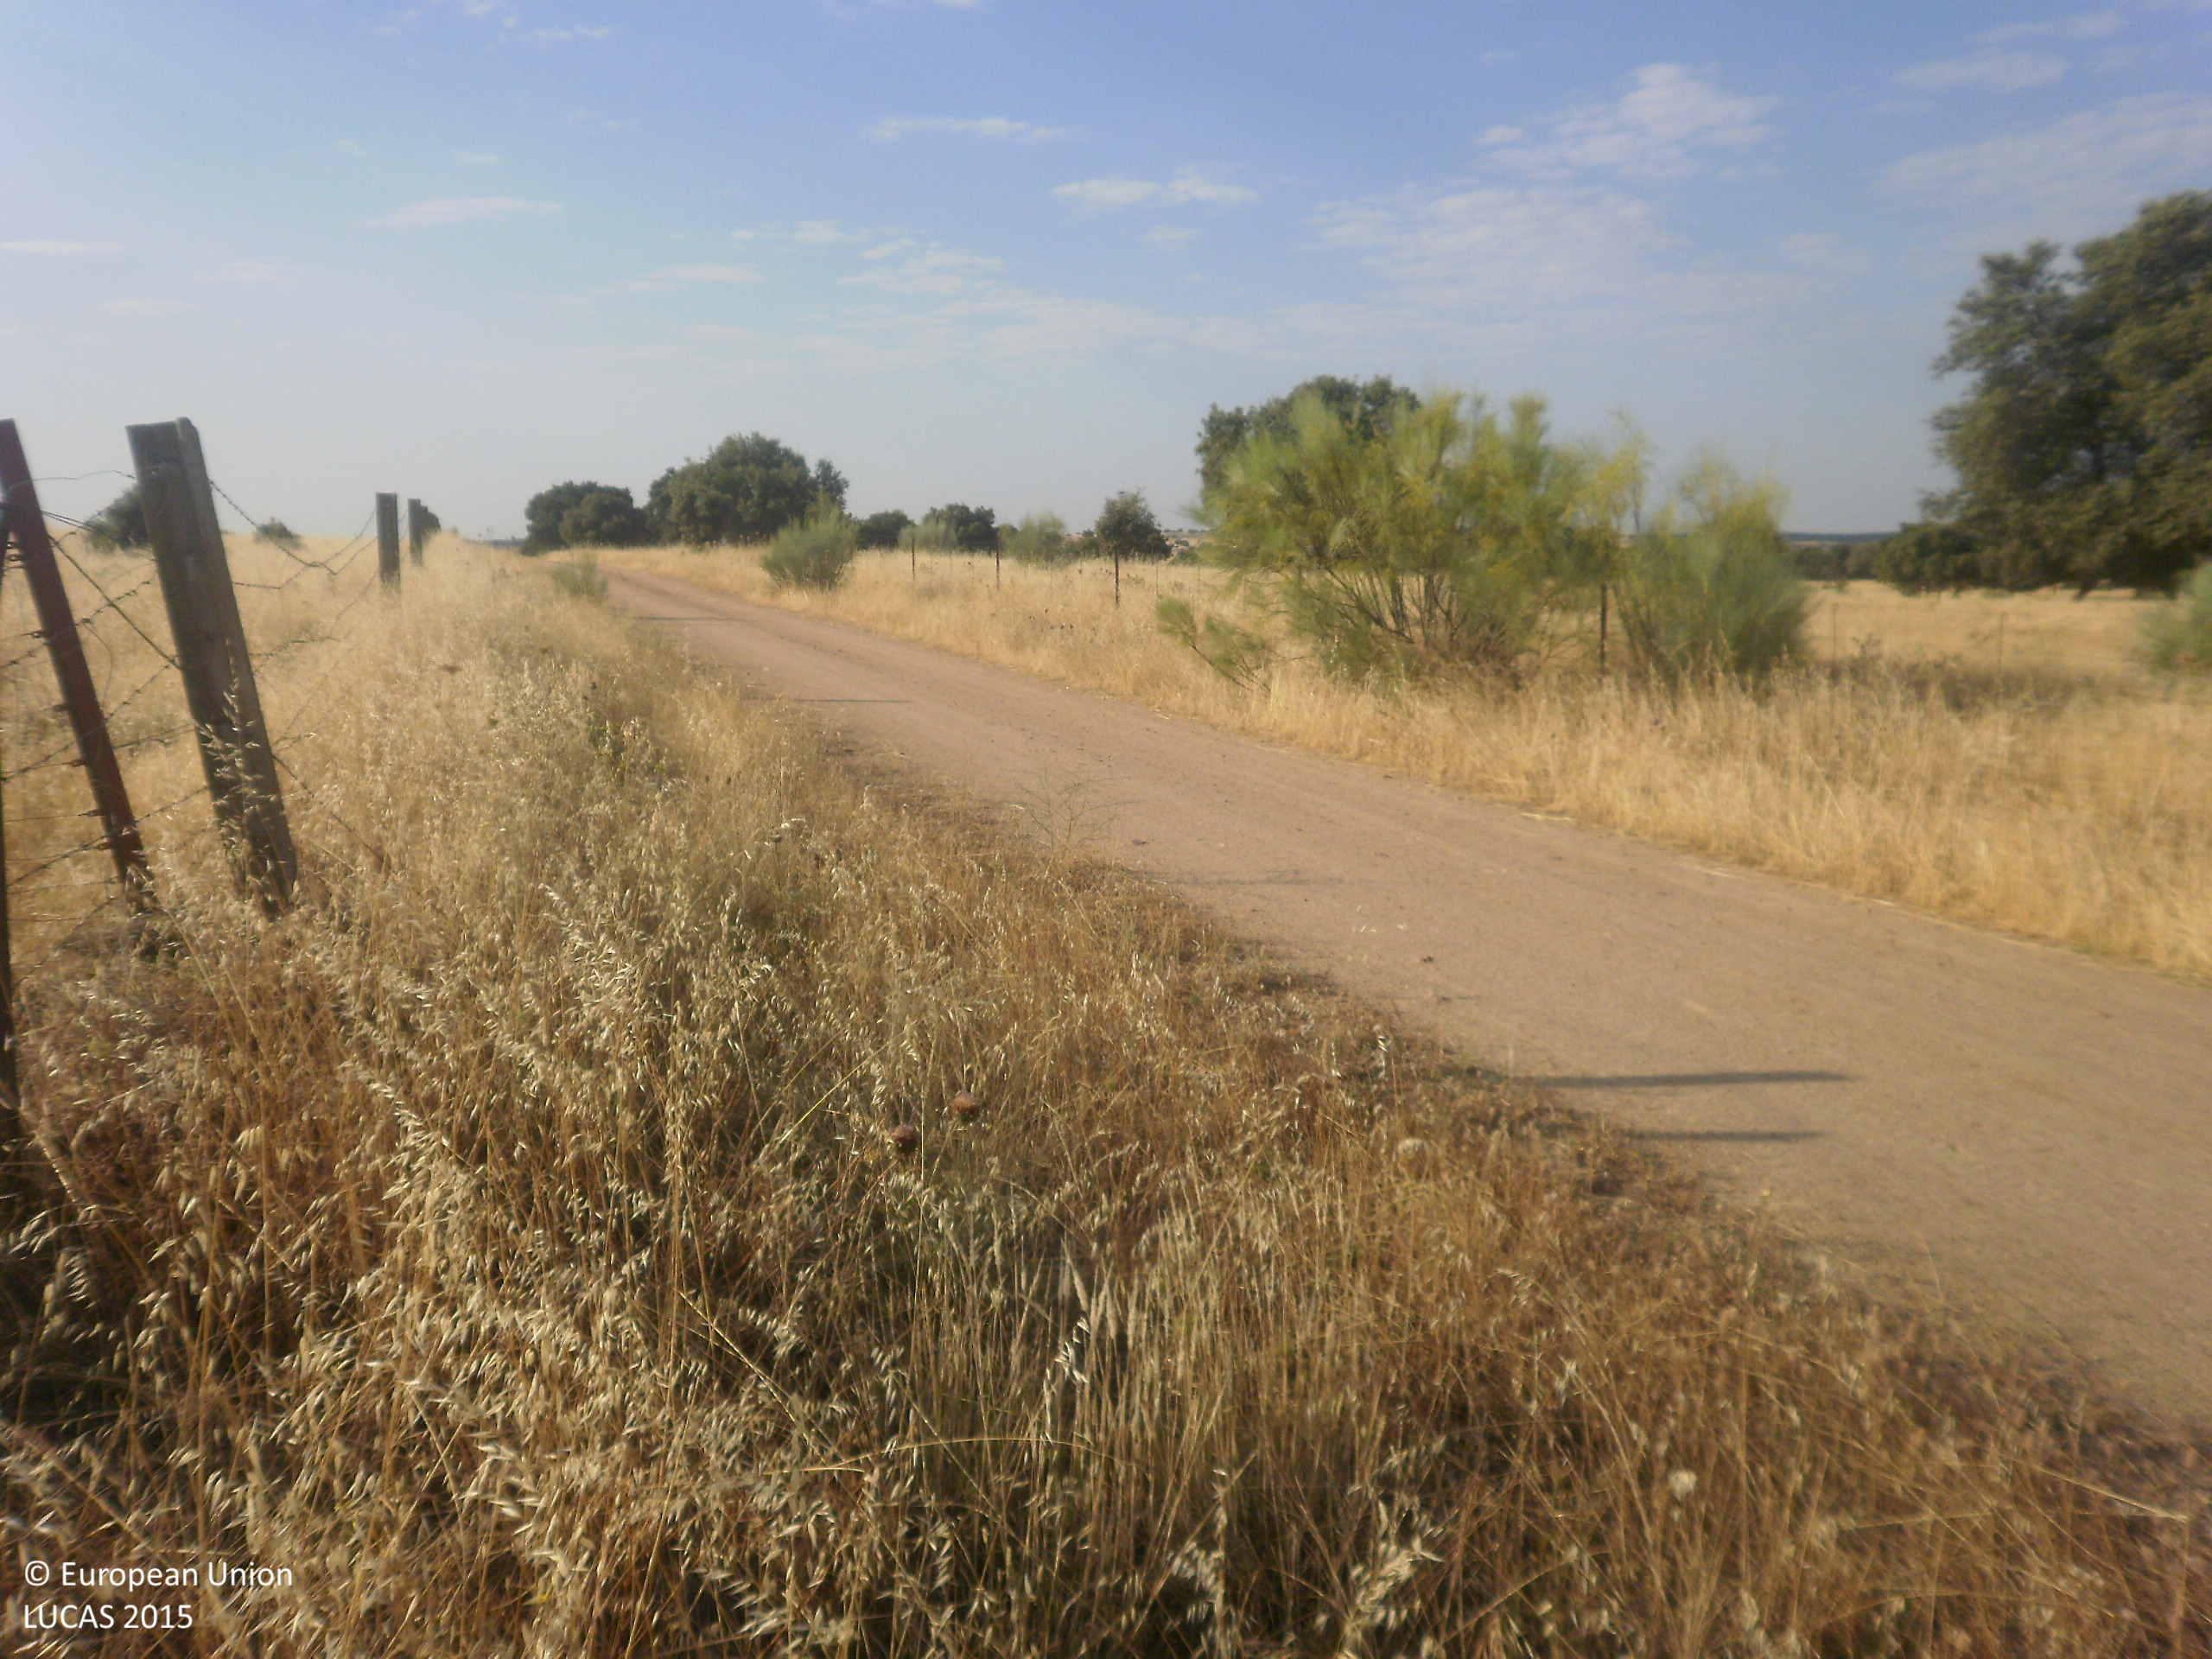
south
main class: Grassland
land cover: Grassland without tree/shrub cover
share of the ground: > 75 %
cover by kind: herbaceous plants 100 %
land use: Agriculture (excluding fallow land and kitchen gardens)
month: June
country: ES
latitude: 39.2638
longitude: -5.8513
